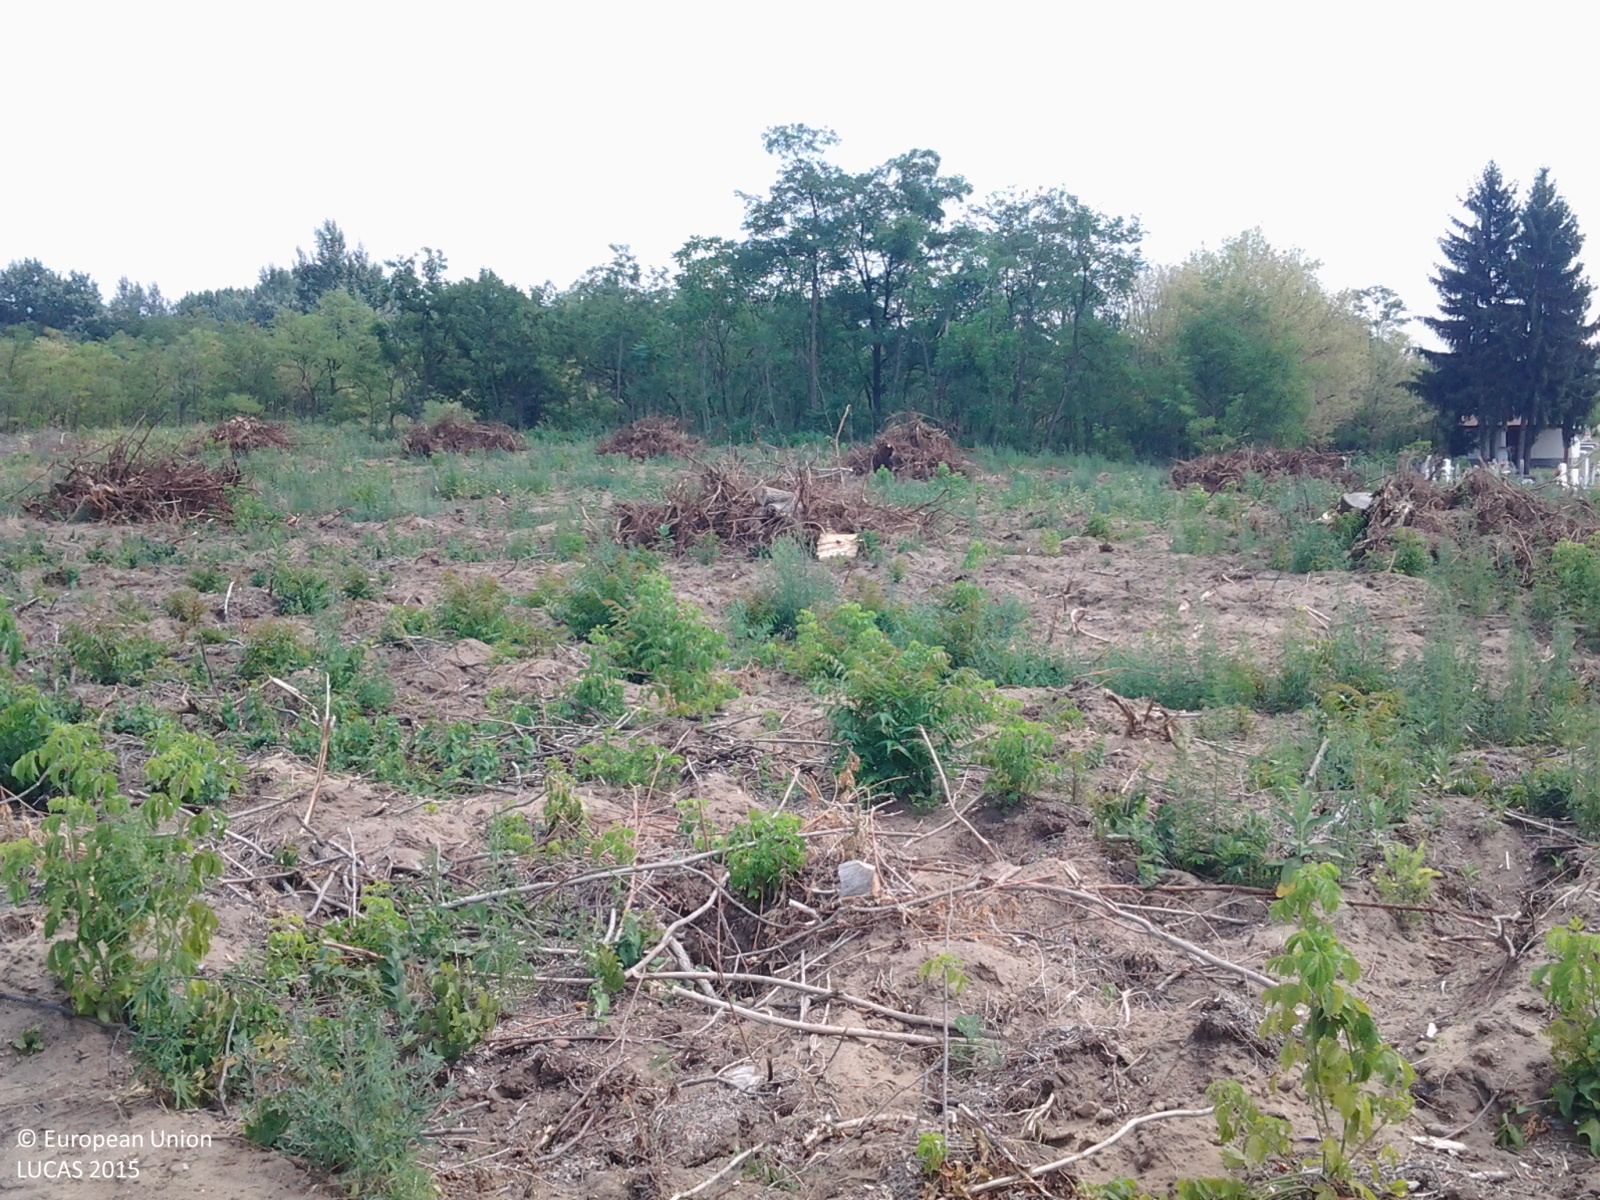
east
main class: Grassland
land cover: Spontaneously vegetated surfaces
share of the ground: 50 - 75 %
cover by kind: herbaceous plants 60 %, unconsolidated bare surface 40 %
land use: Forestry
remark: Clear cut
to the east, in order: Spontaneously vegetated surfaces; Broadleaved woodland
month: July
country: HU
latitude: 47.4120
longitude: 19.9250
